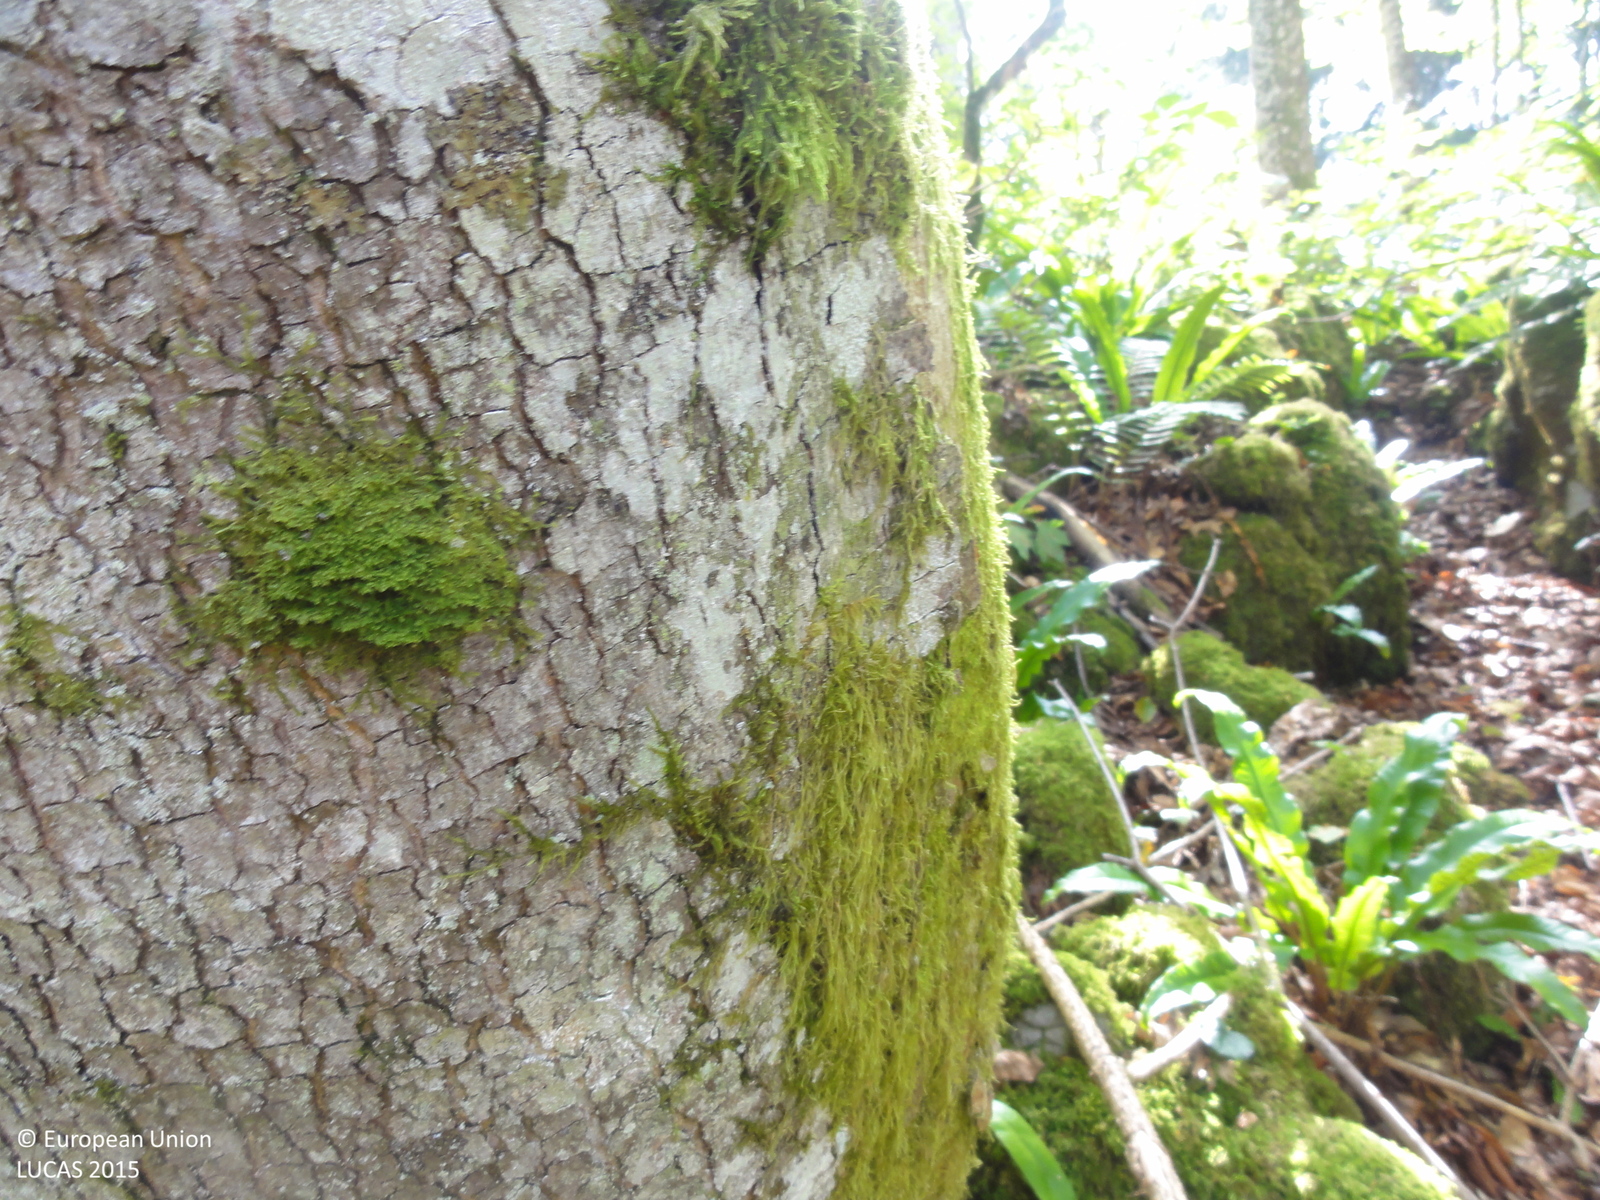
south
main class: Woodland
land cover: Broadleaved woodland
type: beech forest
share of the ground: > 75 %
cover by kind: broadleaved forest trees 90 %, coniferous forest trees 10 %
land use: Forestry
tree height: > 5 m
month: September
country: SI
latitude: 45.5806
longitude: 15.0838
